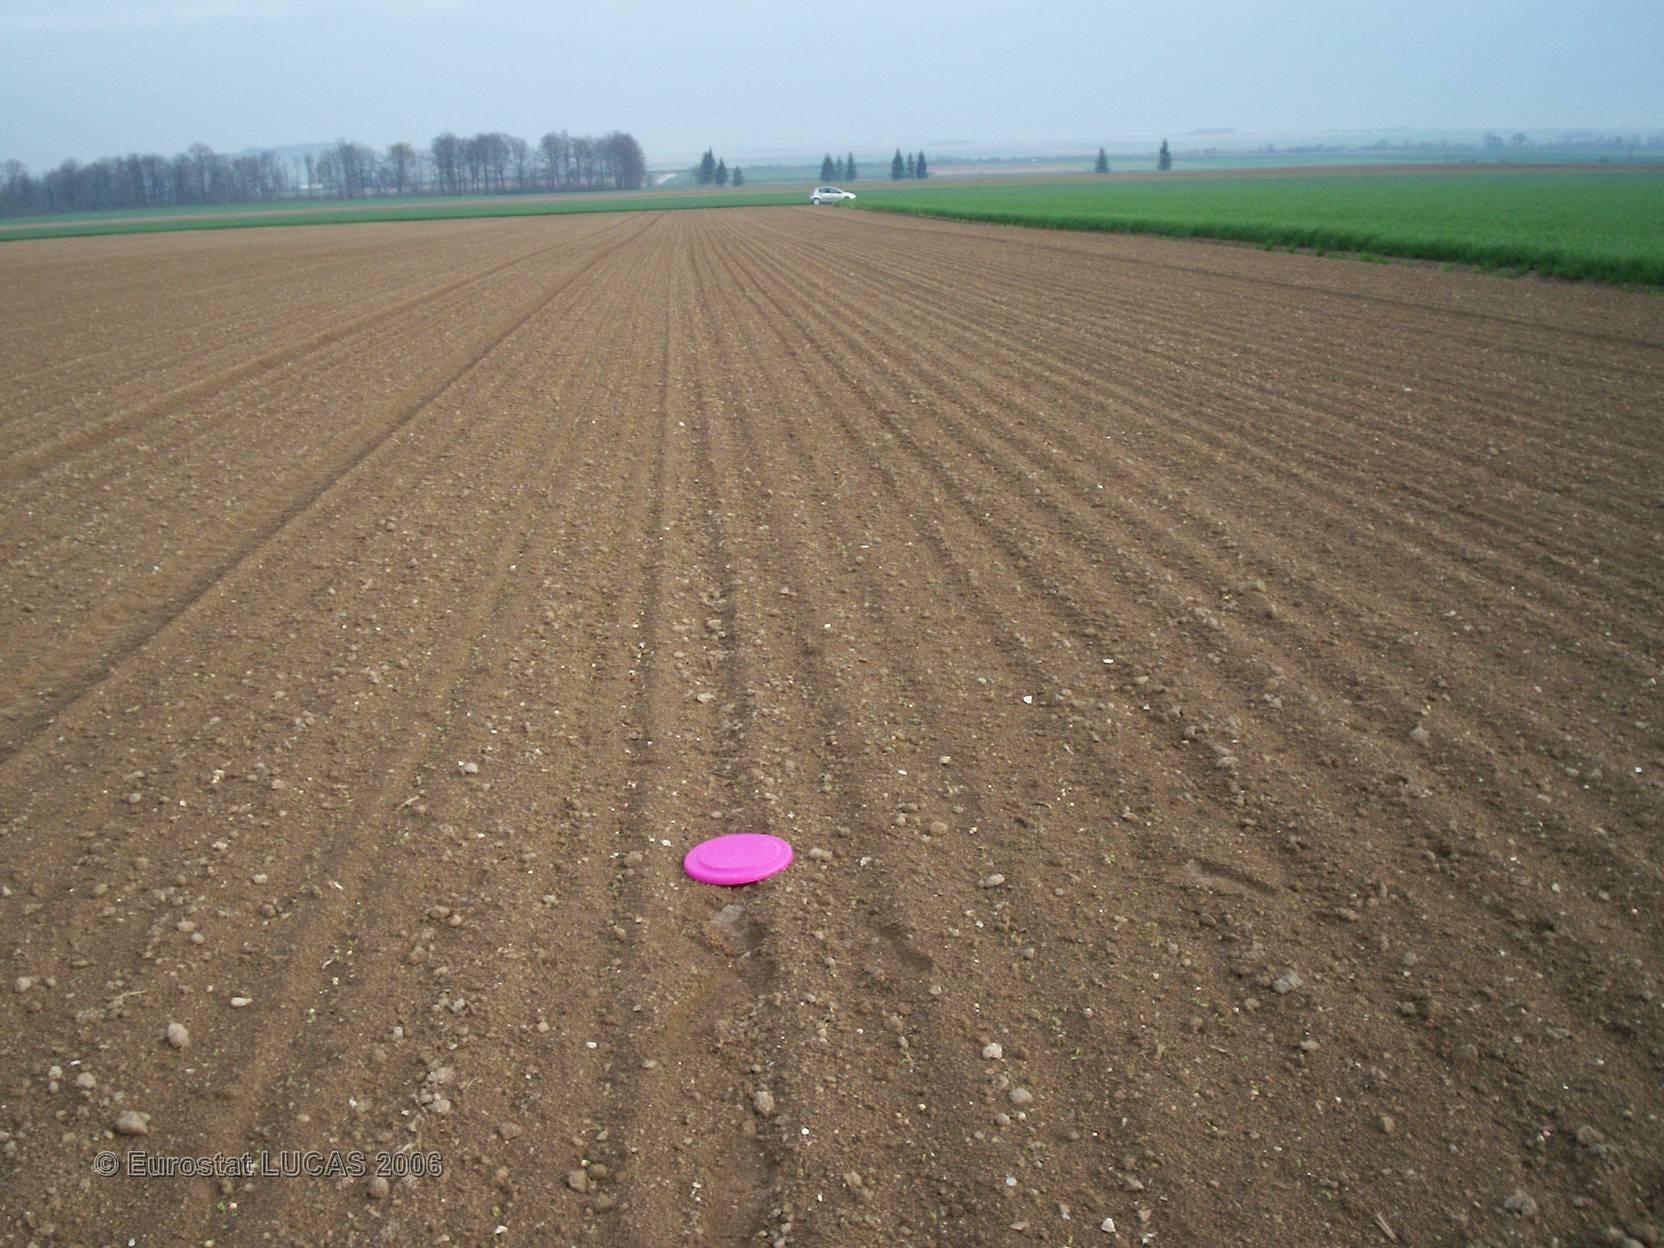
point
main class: Cropland
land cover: Dry pulses
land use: Agriculture (excluding fallow land and kitchen gardens)
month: April
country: FR
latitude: 48.7247
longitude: 3.9460
